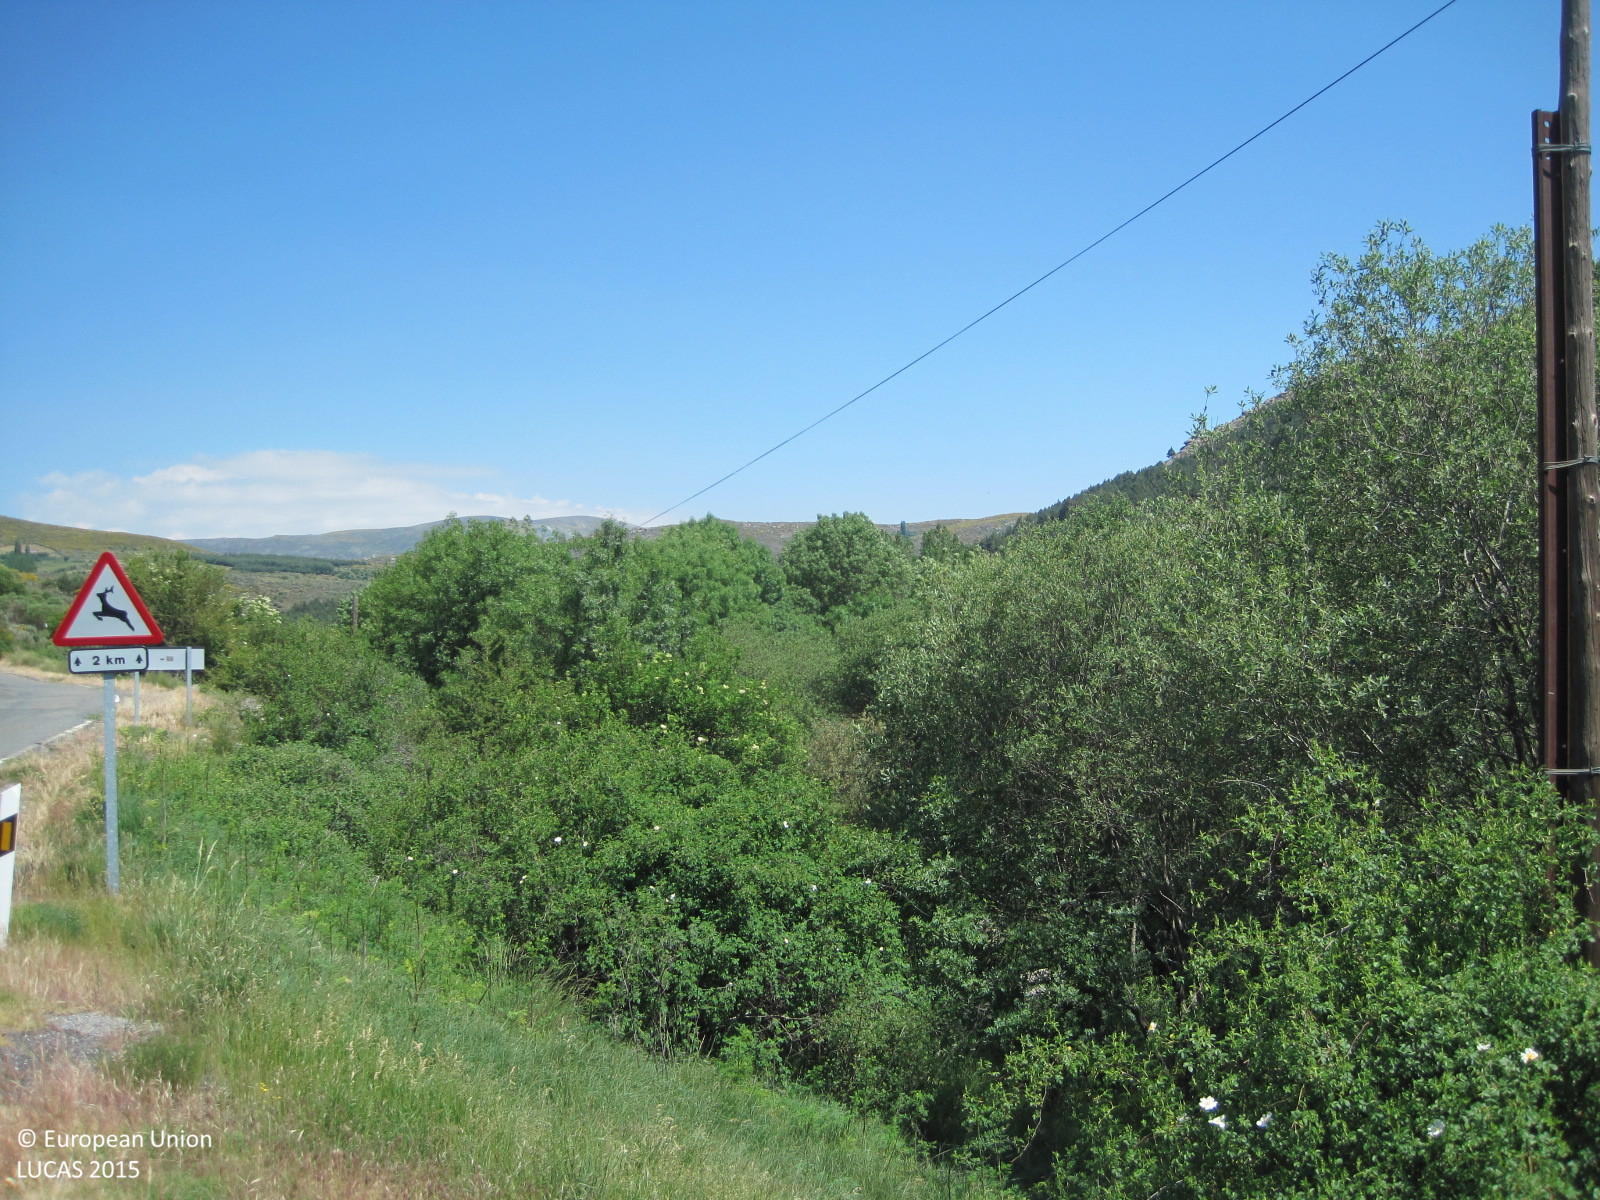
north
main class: Shrubland
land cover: Shrubland without tree cover
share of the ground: > 75 %
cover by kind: shrubs 100 %
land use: Semi-natural and natural areas not in use
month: June
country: ES
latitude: 40.4053
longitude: -5.0341
